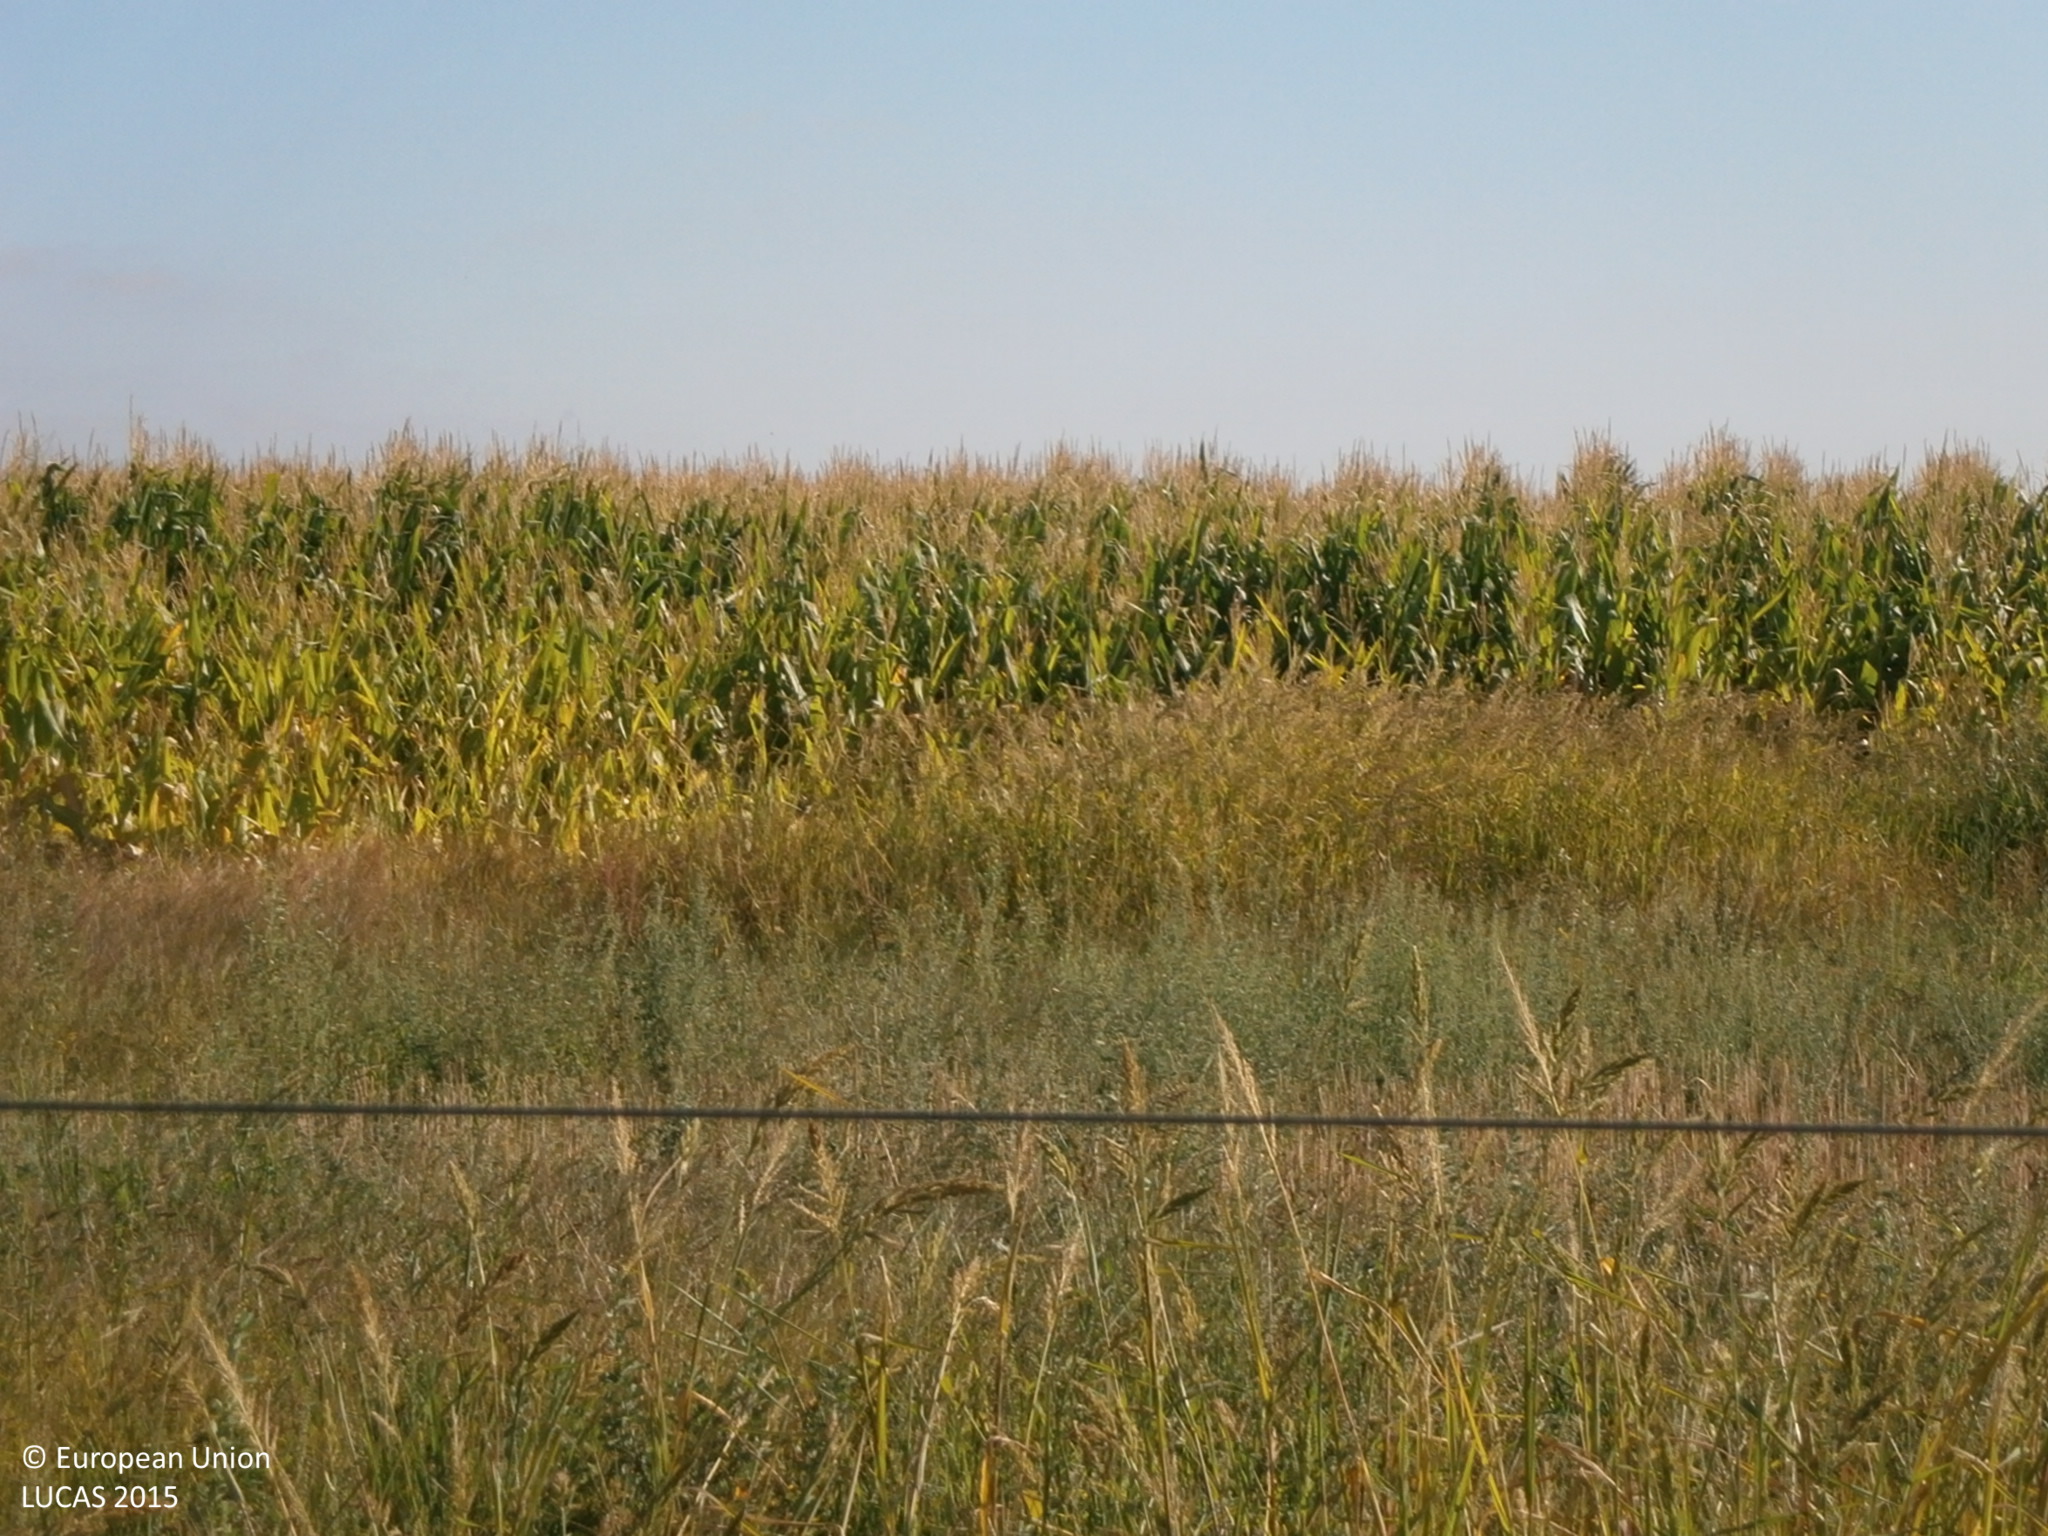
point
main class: Cropland
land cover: Maize
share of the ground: > 75 %
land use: Agriculture (excluding fallow land and kitchen gardens)
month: July
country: ES
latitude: 38.7311
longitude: -7.2240
